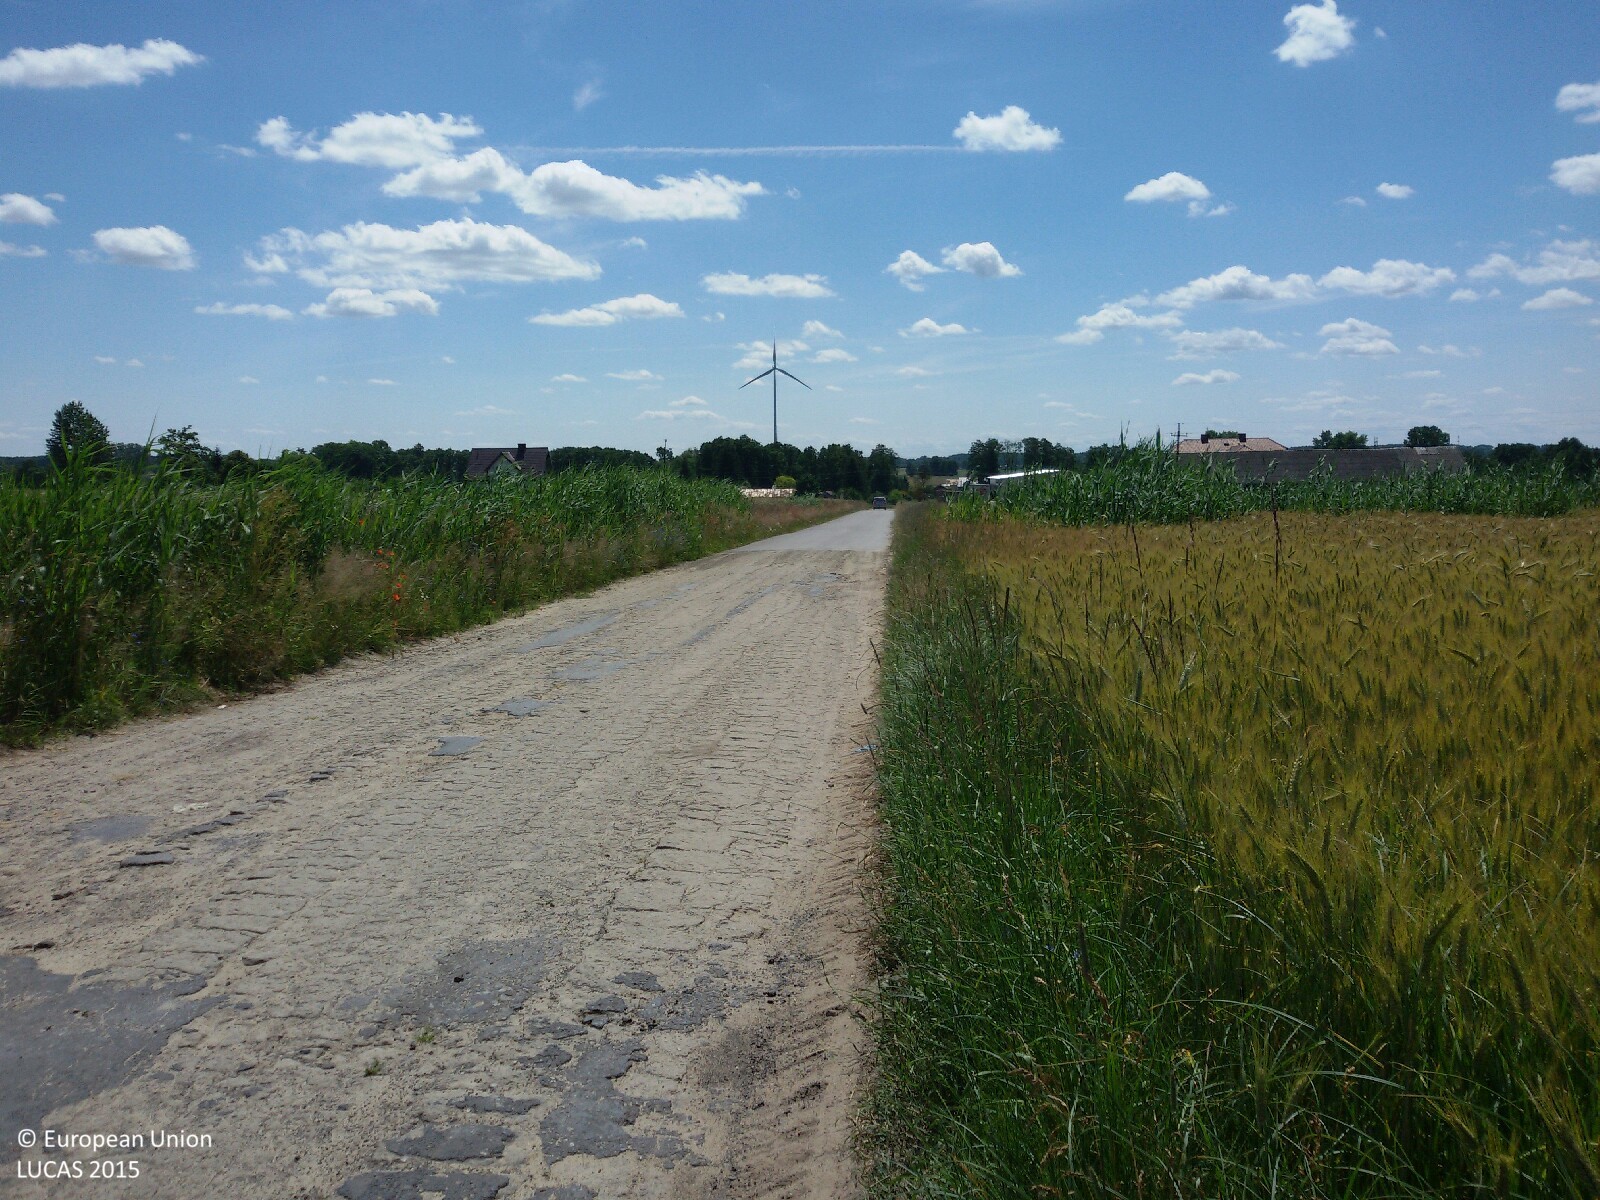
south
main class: Cropland
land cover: Rye
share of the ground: > 75 %
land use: Agriculture (excluding fallow land and kitchen gardens)
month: July
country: PL
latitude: 51.7791
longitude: 21.6929
